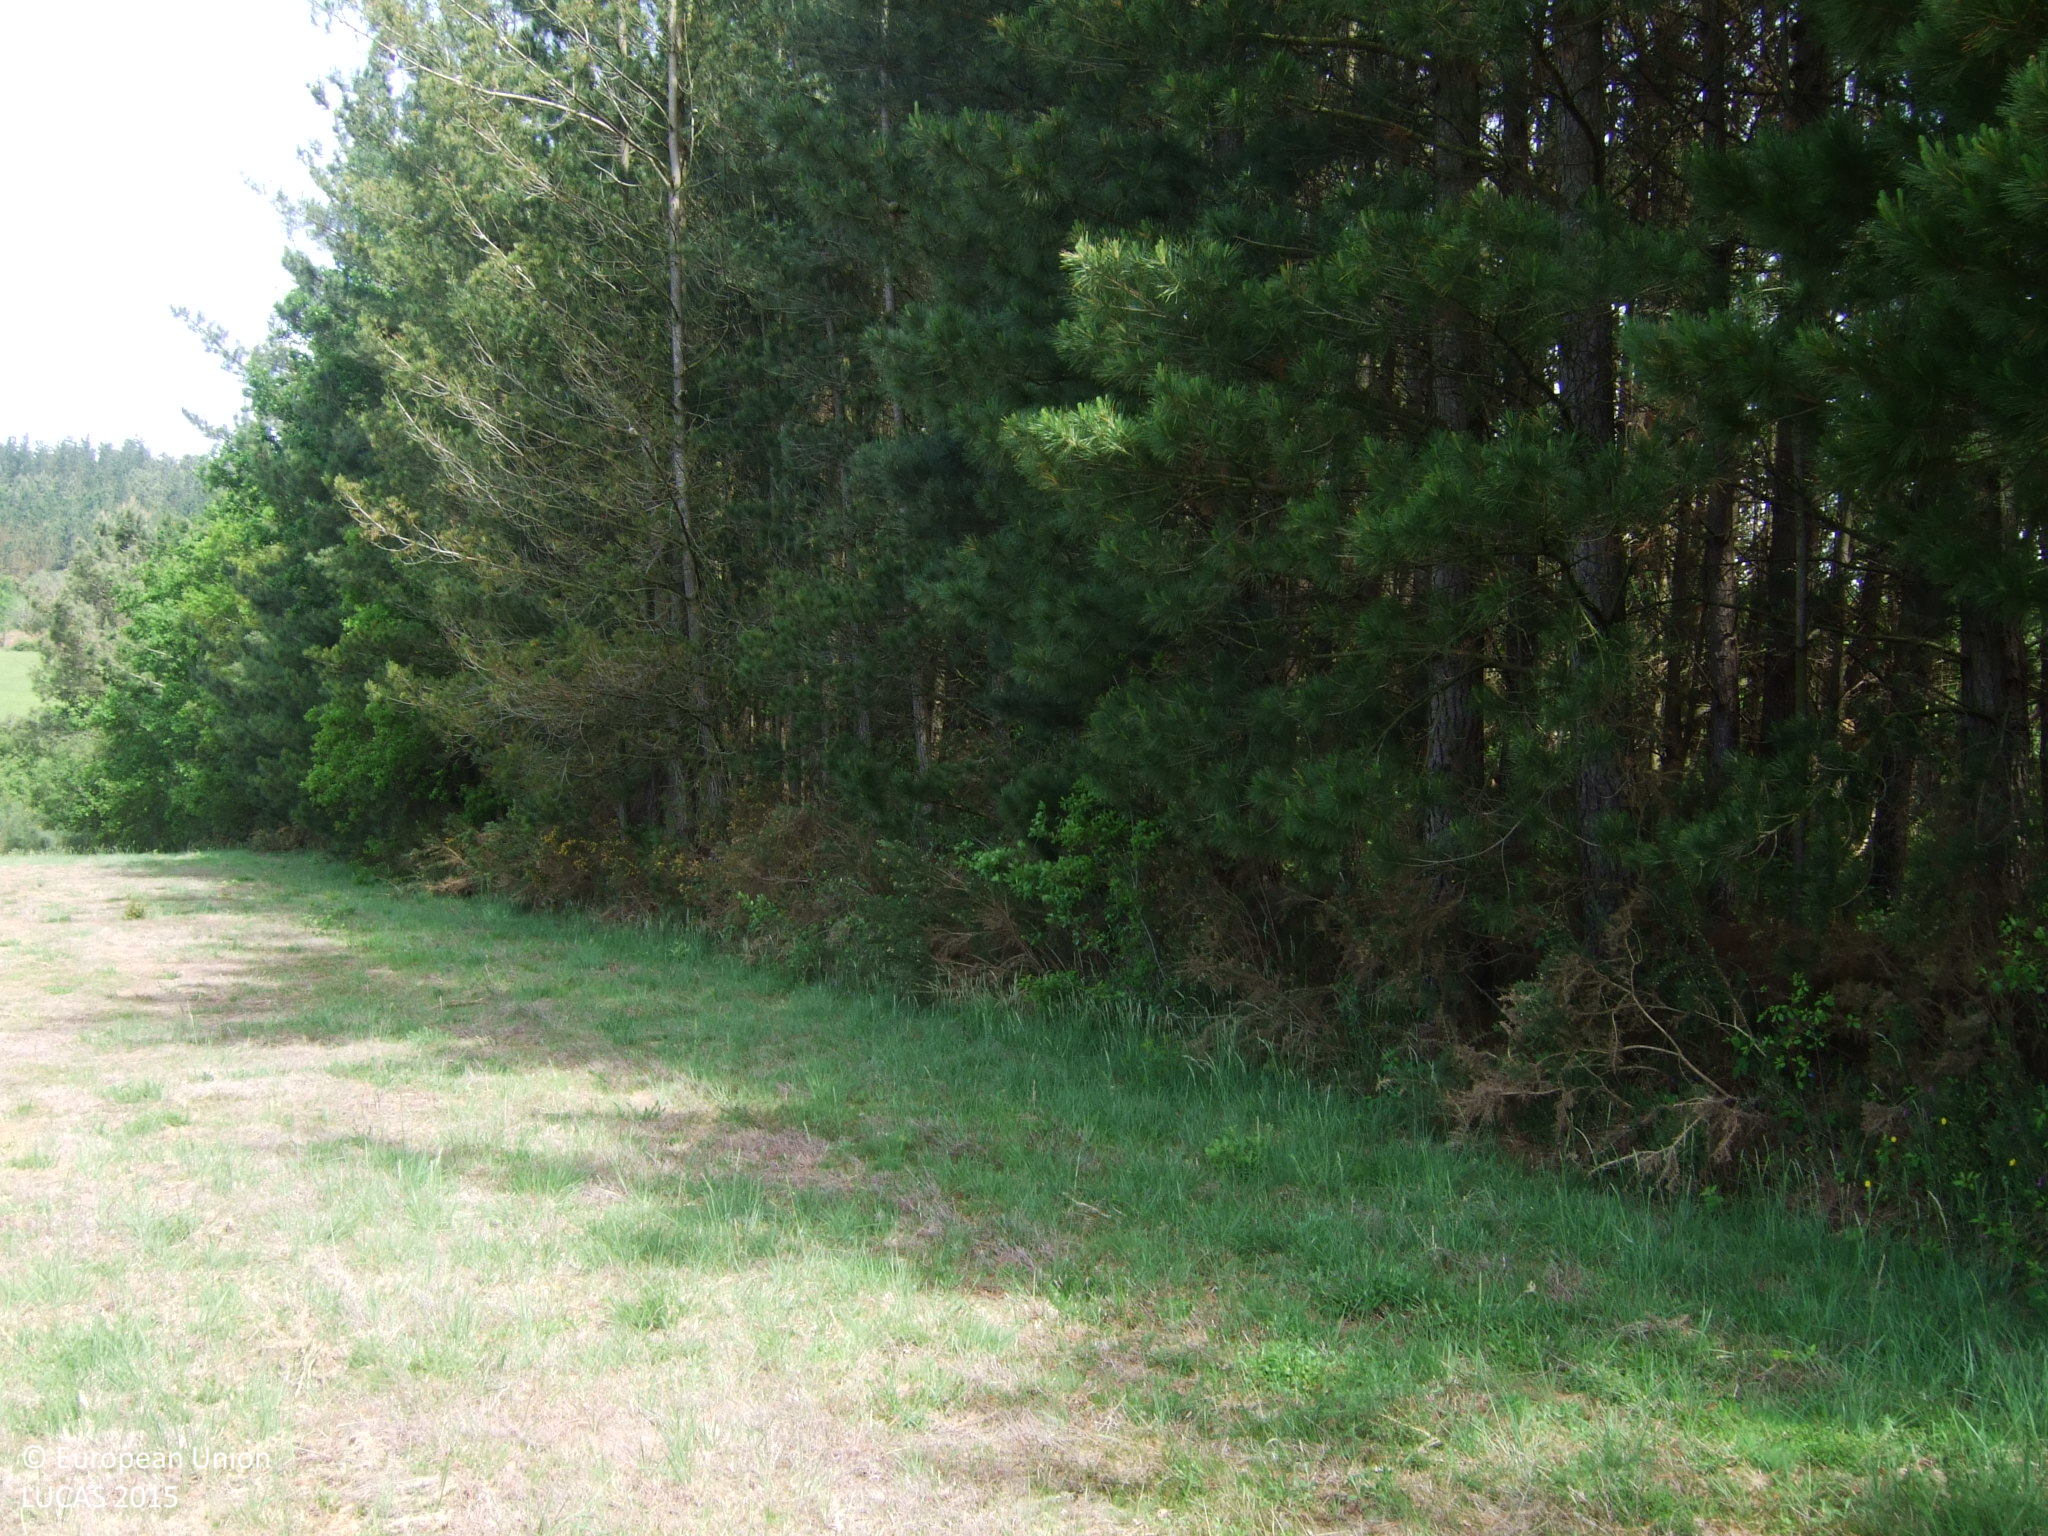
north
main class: Grassland
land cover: Grassland without tree/shrub cover
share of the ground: > 75 %
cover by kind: herbaceous plants 100 %
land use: Agriculture (excluding fallow land and kitchen gardens)
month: May
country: ES
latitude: 42.8856
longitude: -7.3966
